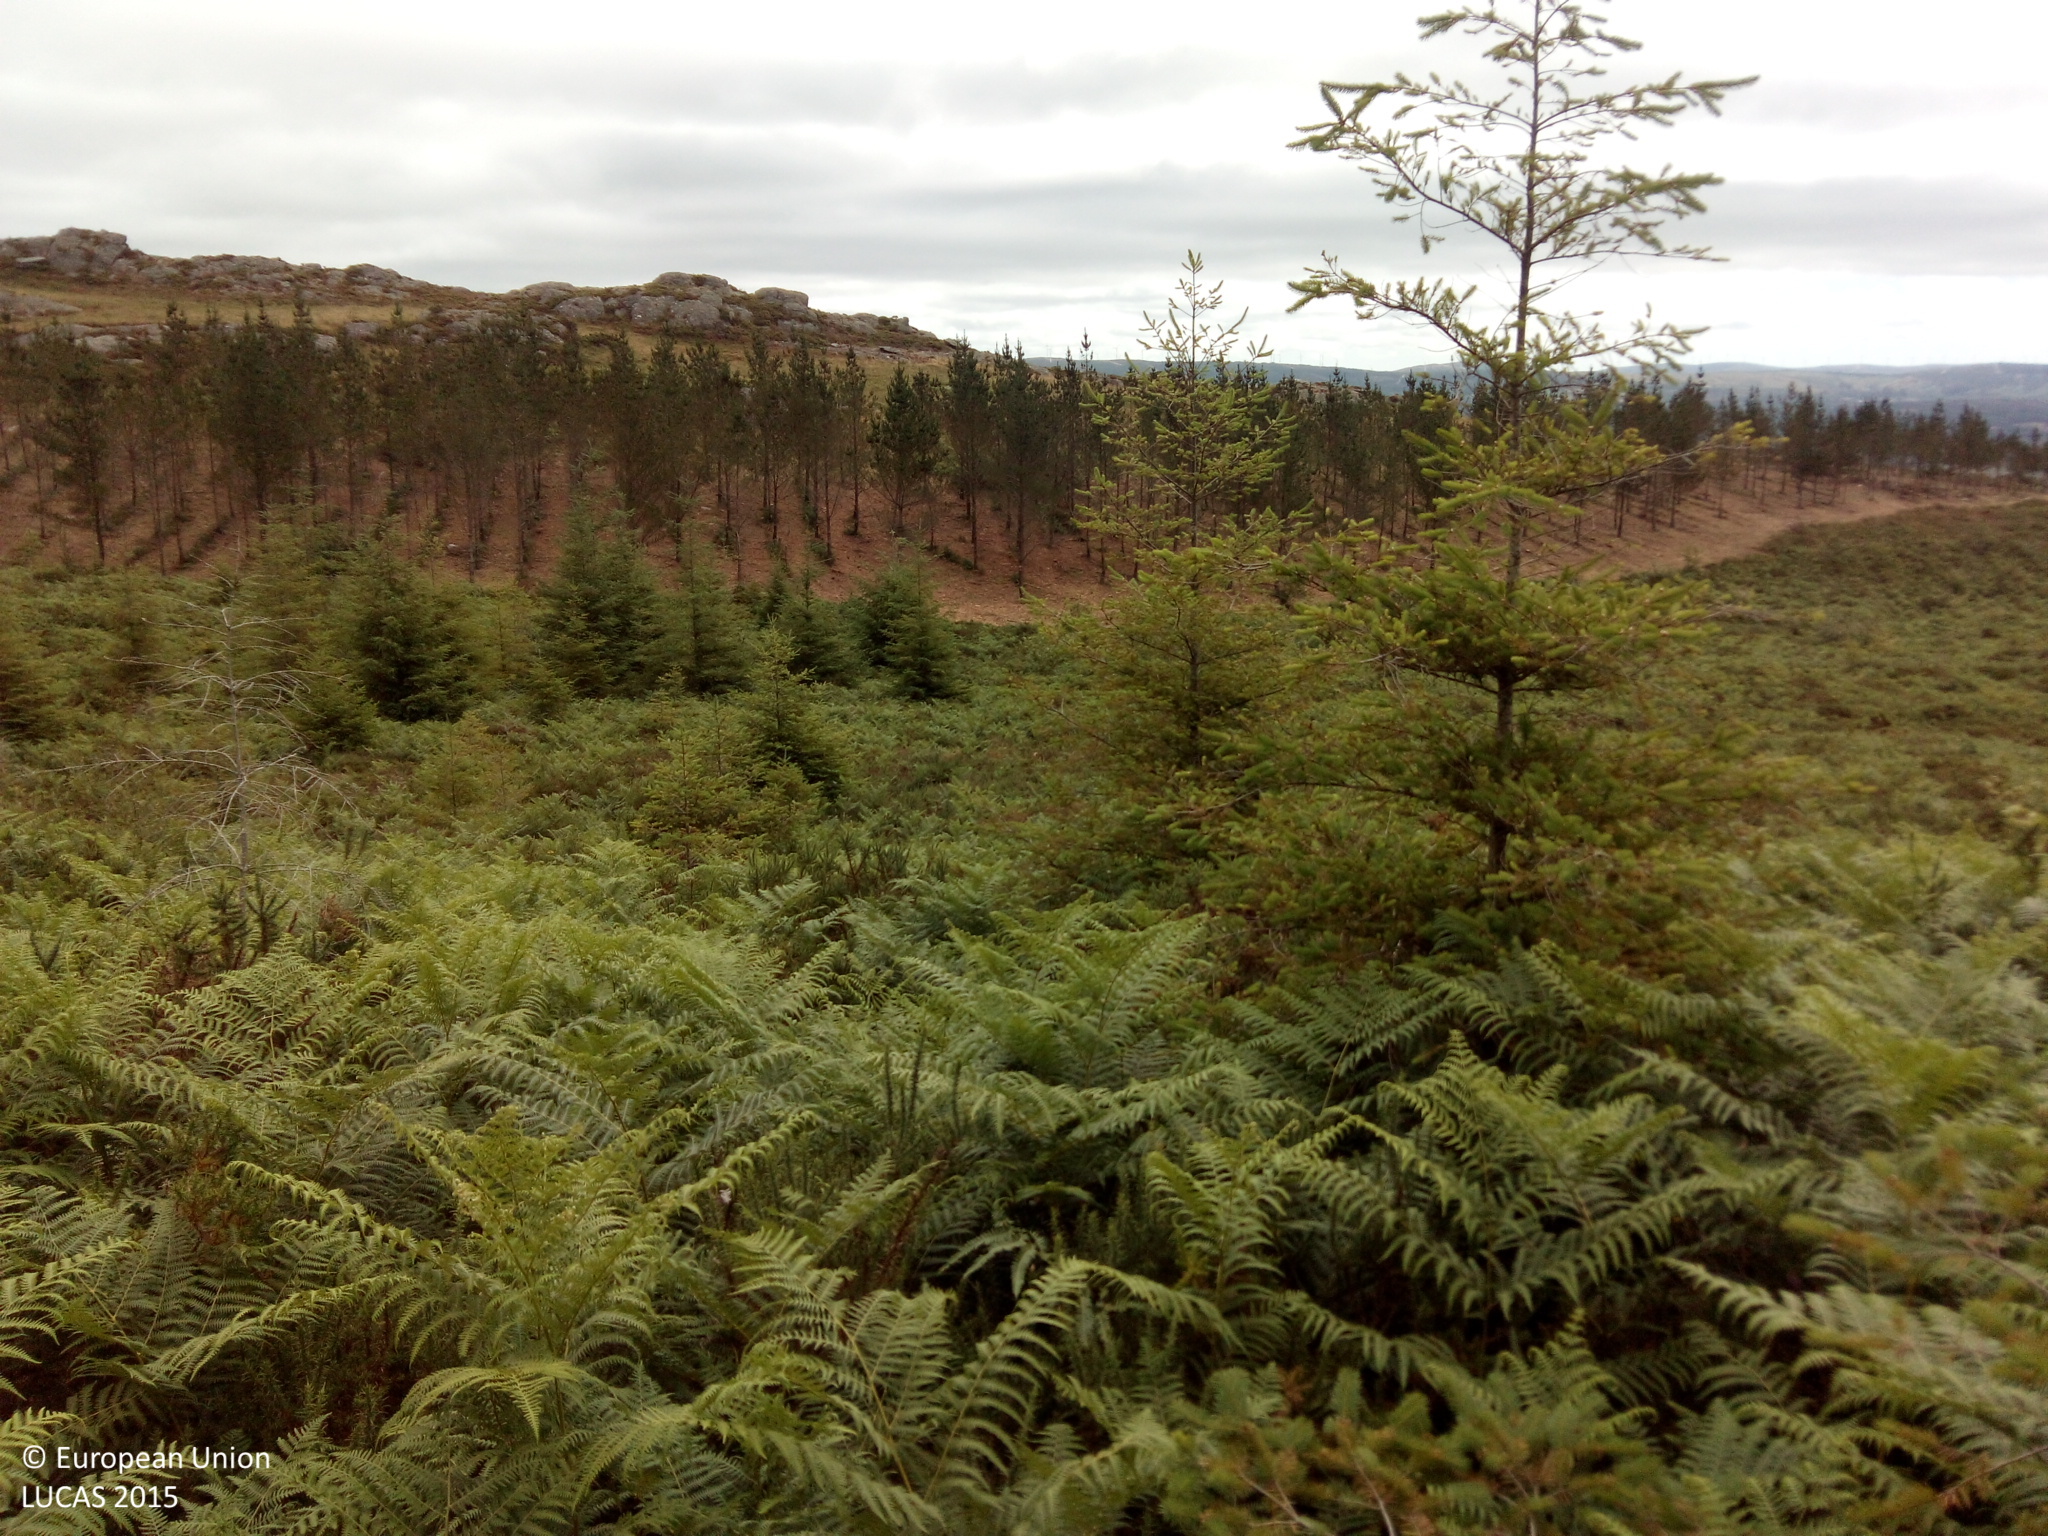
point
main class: Woodland
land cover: Spruce dominated coniferous woodland
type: exotic forest
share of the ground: > 75 %
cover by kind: shrubs 70 %, coniferous forest trees 30 %
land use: Forestry
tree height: < 5 m
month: July
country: ES
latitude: 42.5797
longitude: -8.3839
